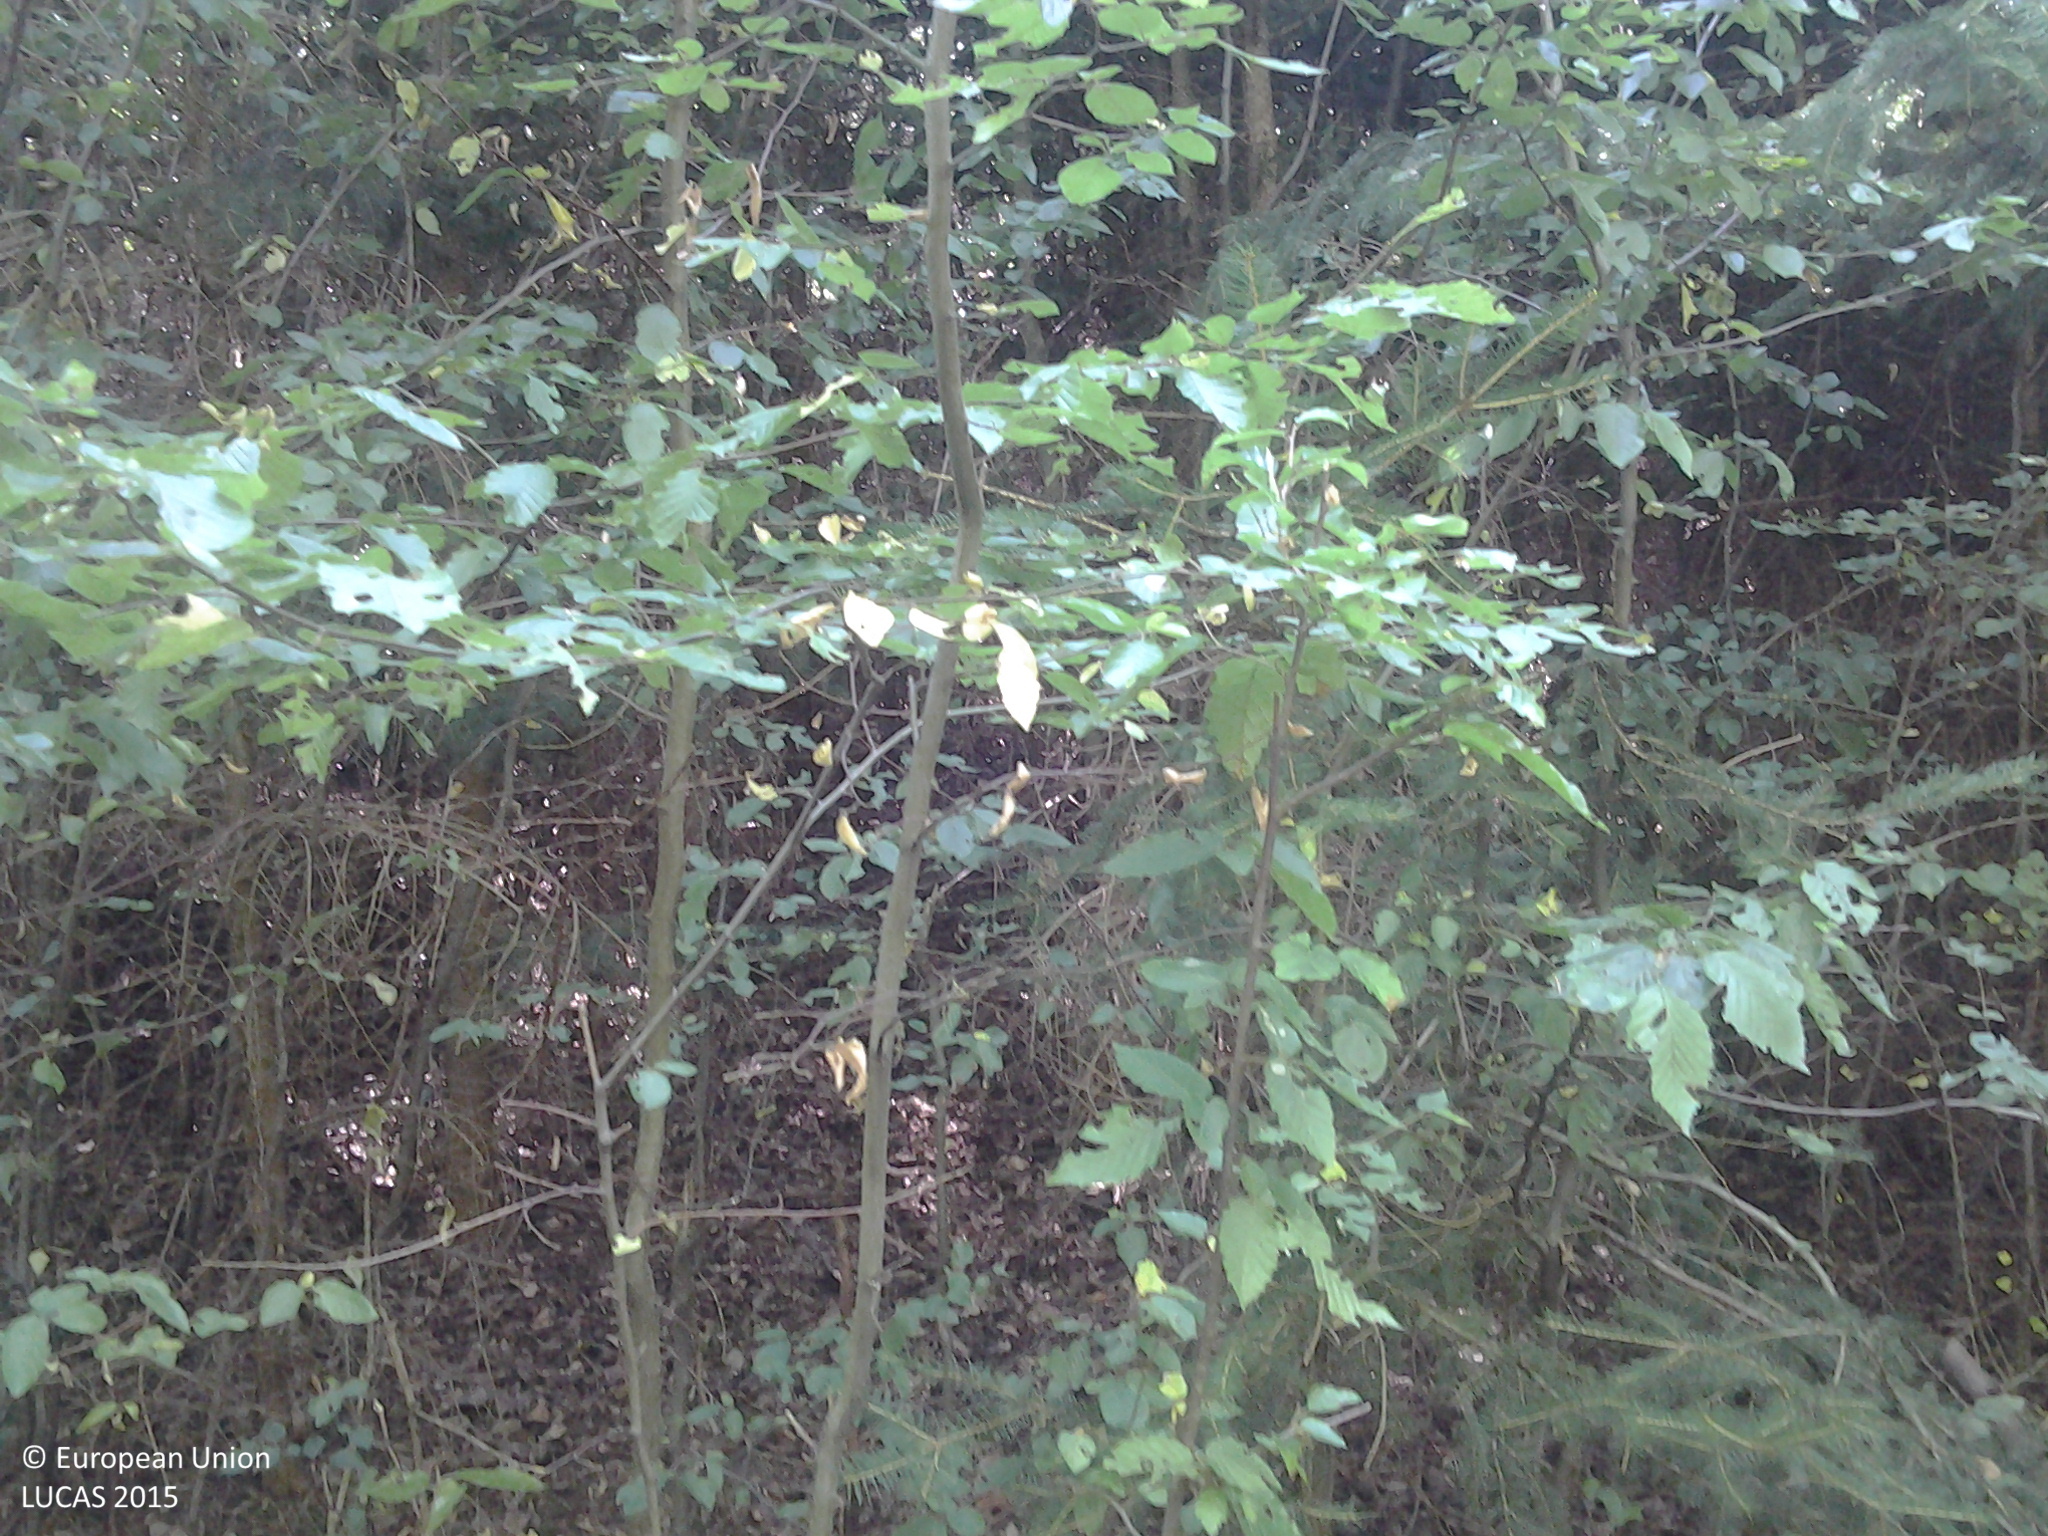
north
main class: Woodland
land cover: Broadleaved woodland
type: beech forest
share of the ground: > 75 %
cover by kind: broadleaved forest trees 85 %, shrubs 15 %
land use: Forestry
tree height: > 5 m
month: August
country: HU
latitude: 47.9382
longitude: 19.9197
